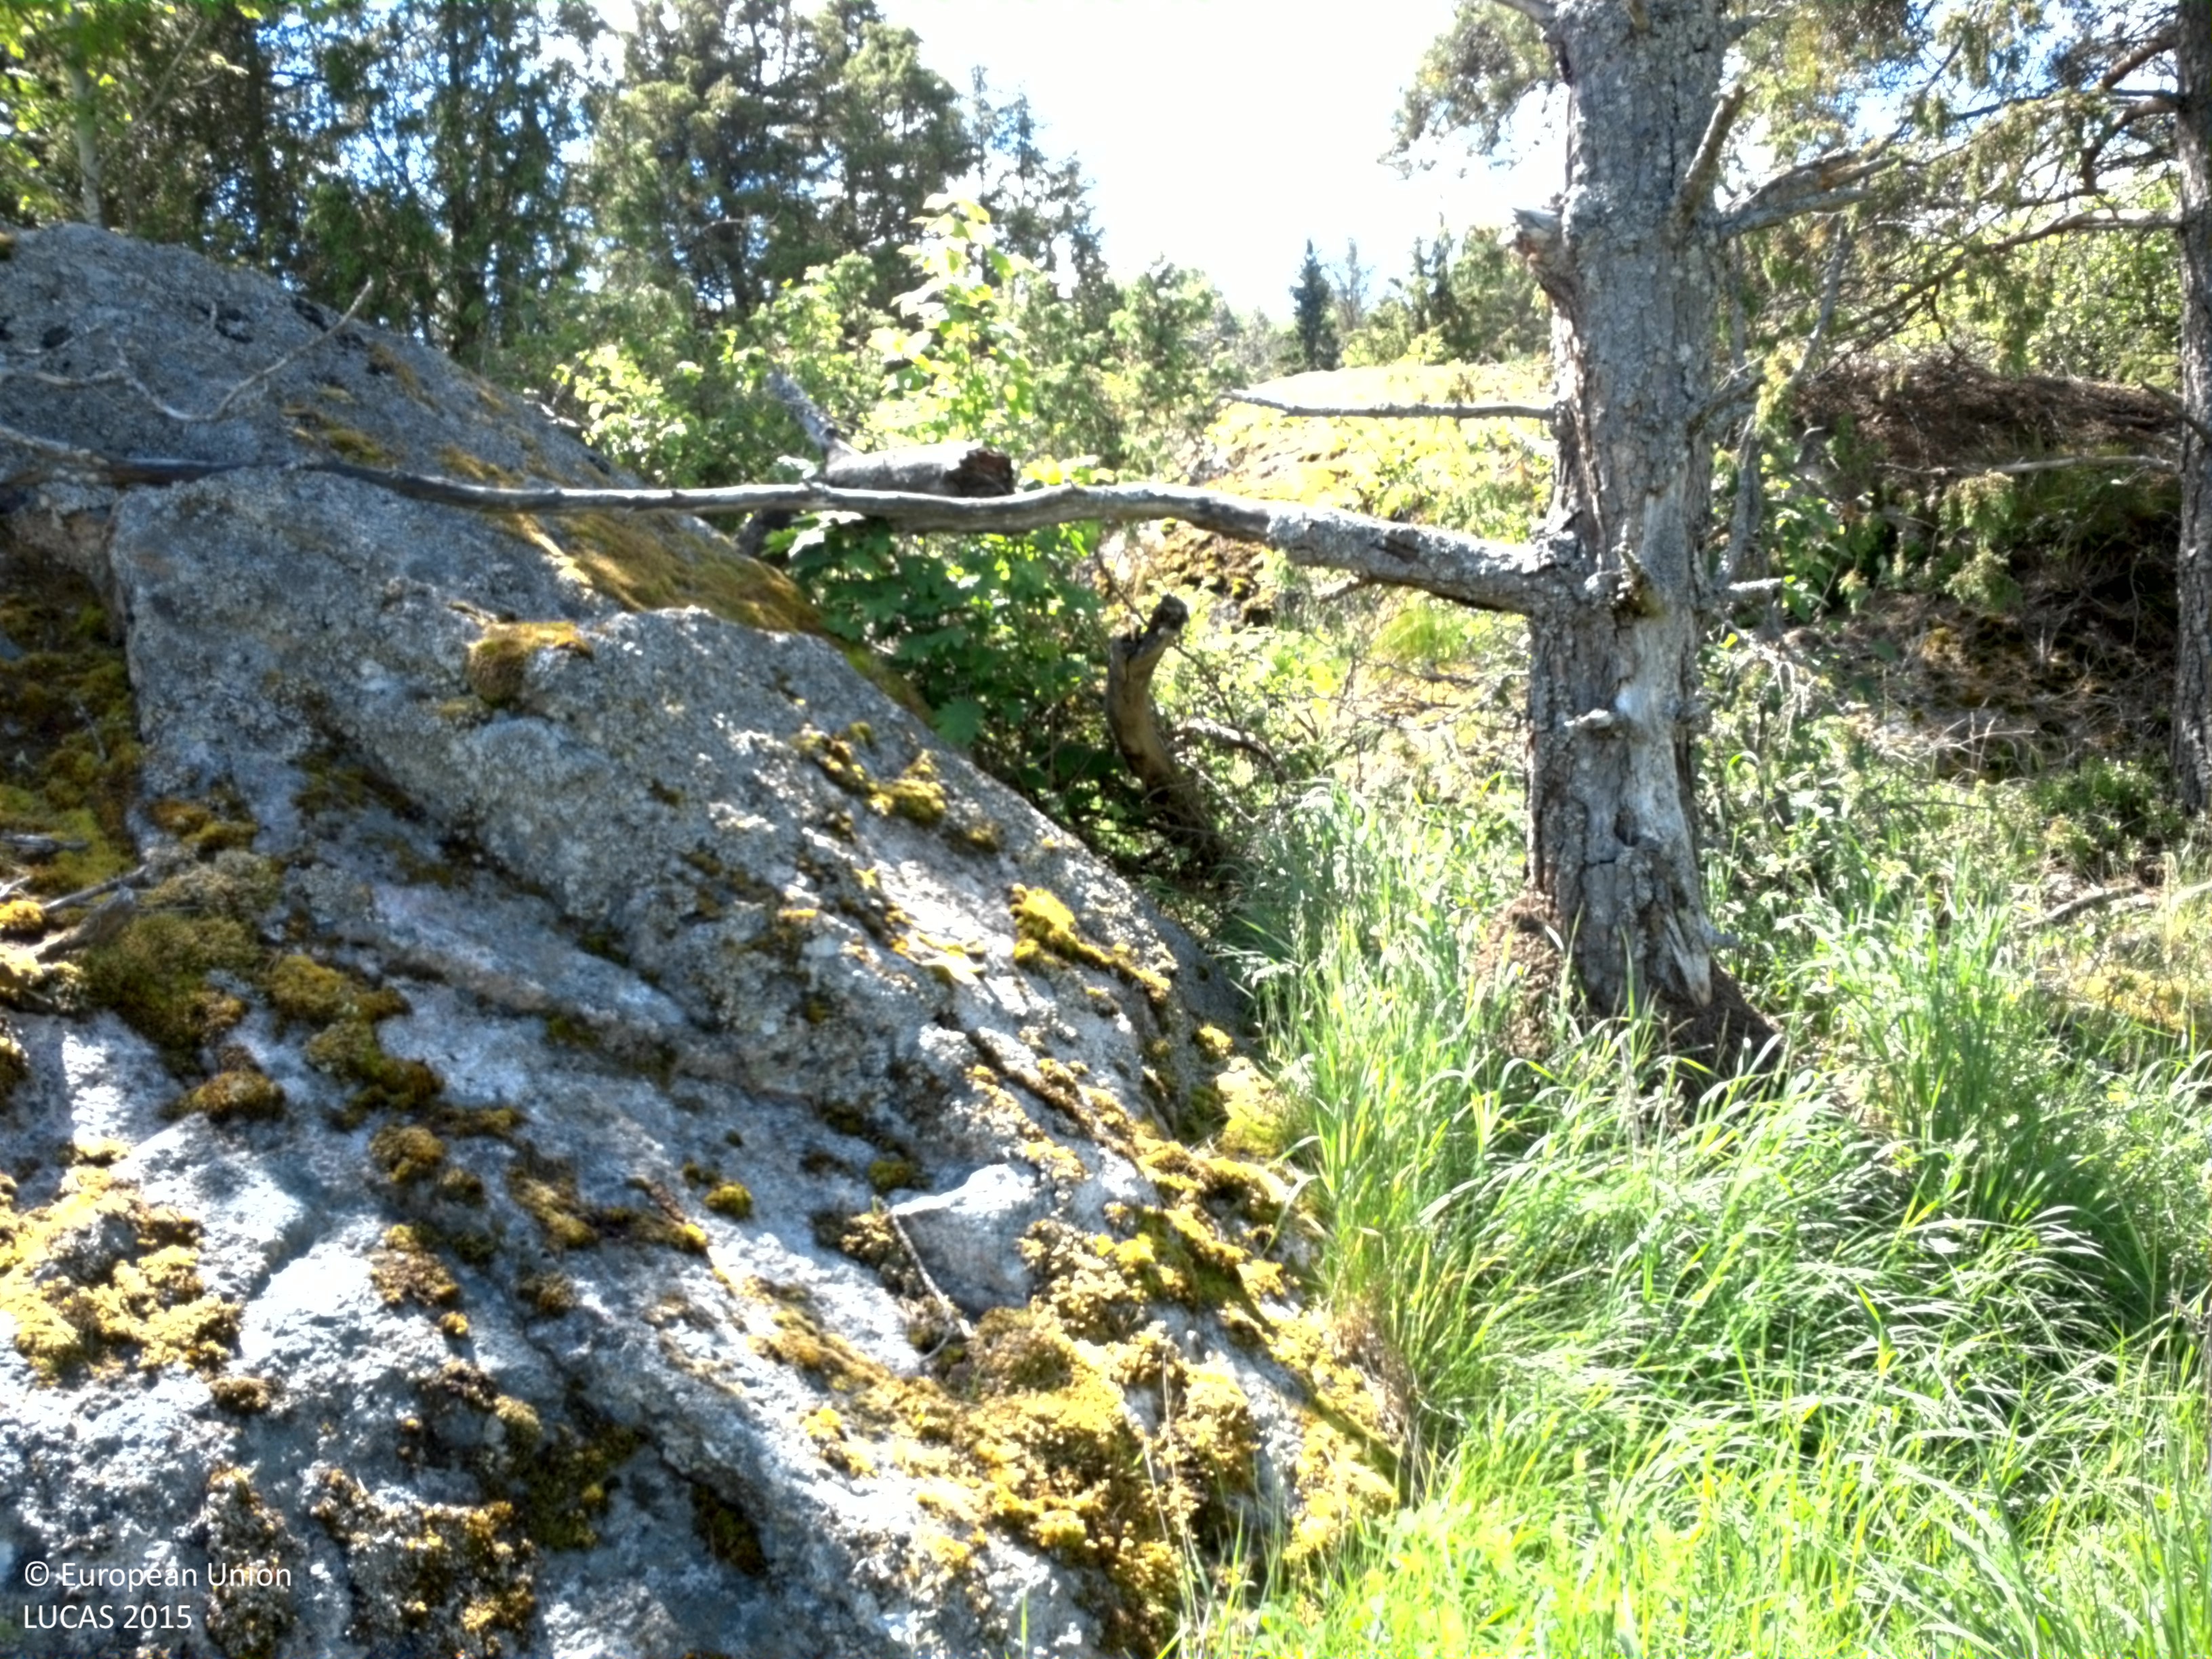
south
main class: Grassland
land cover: Grassland with sparse tree/shrub cover
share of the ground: > 75 %
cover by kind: herbaceous plants 90 %, coniferous forest trees 5 %, shrubs 5 %
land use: Agriculture (excluding fallow land and kitchen gardens)
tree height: > 5 m
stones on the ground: < 10 %
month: June
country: SE
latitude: 59.9452
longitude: 17.4938
